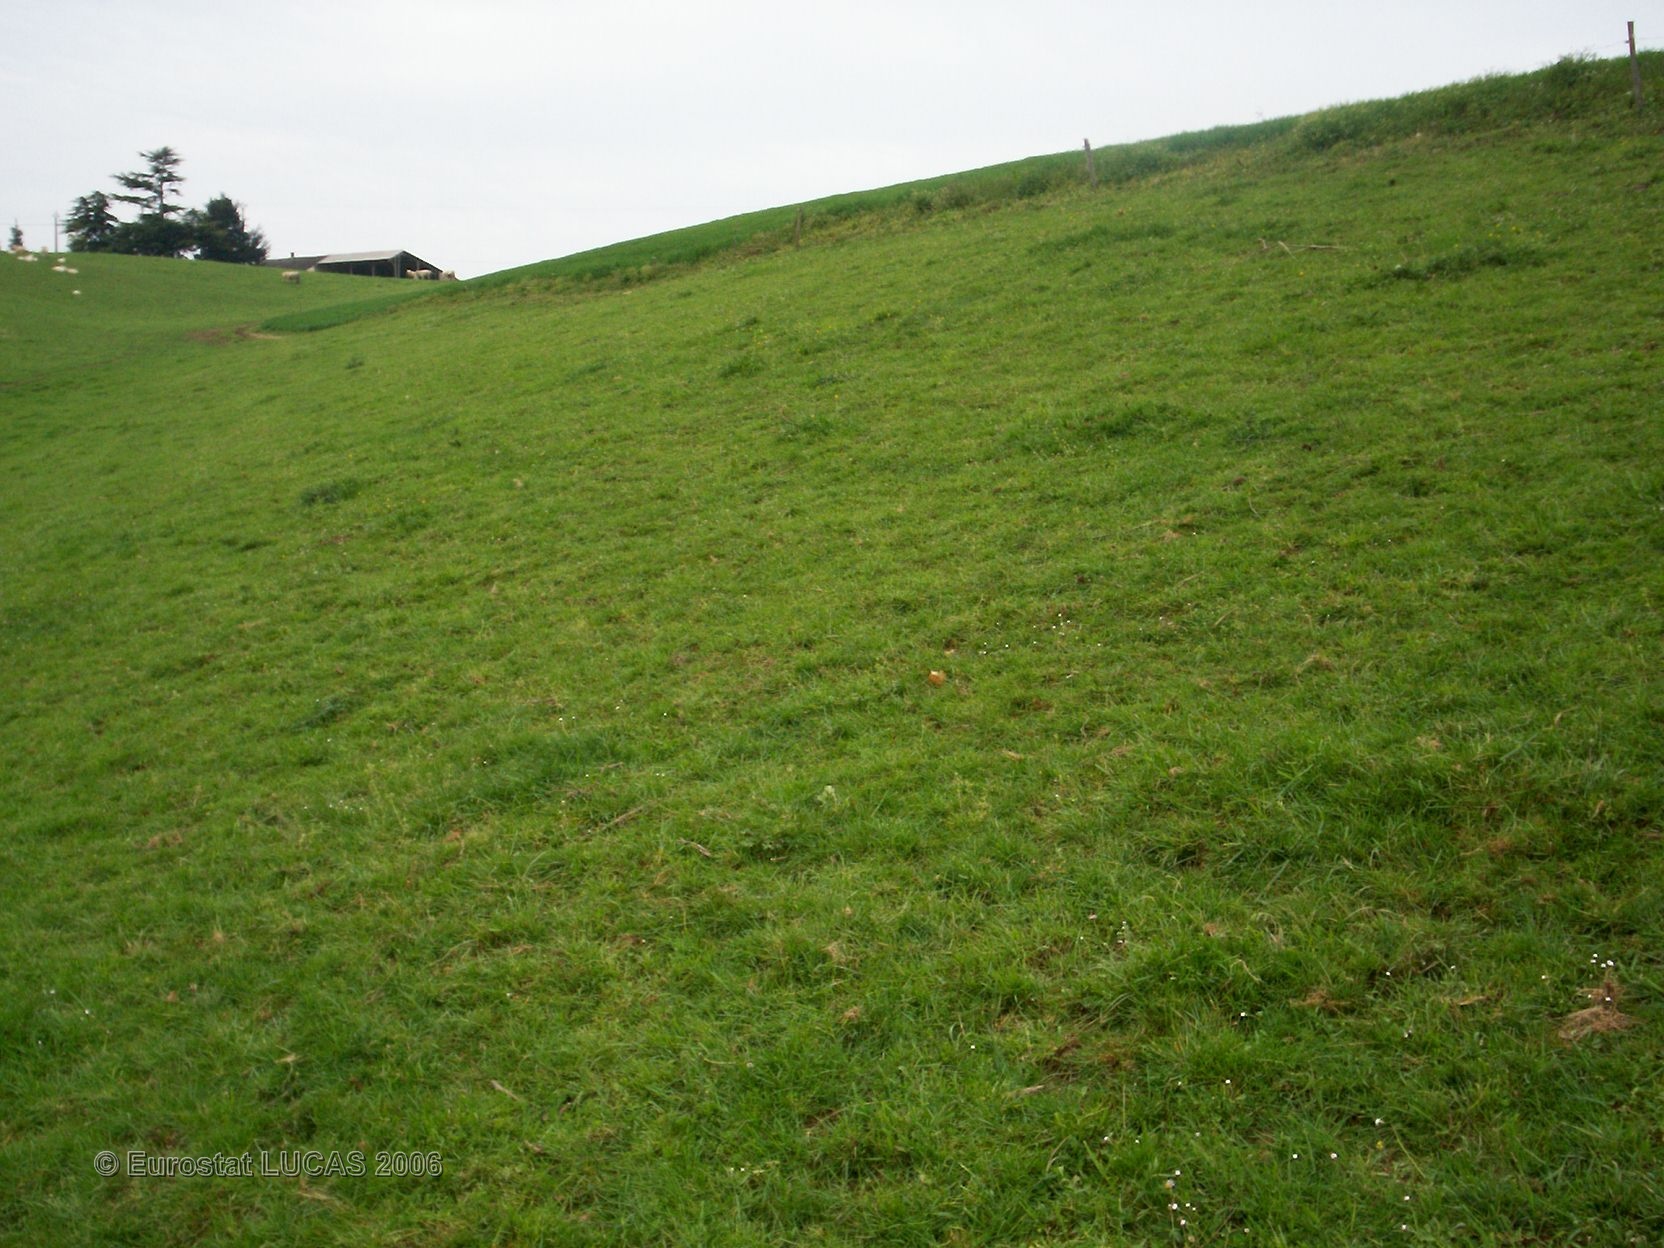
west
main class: Grassland
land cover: Grassland without tree/shrub cover
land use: Agriculture (excluding fallow land and kitchen gardens)
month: April
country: FR
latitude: 43.5614
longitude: 0.2280
